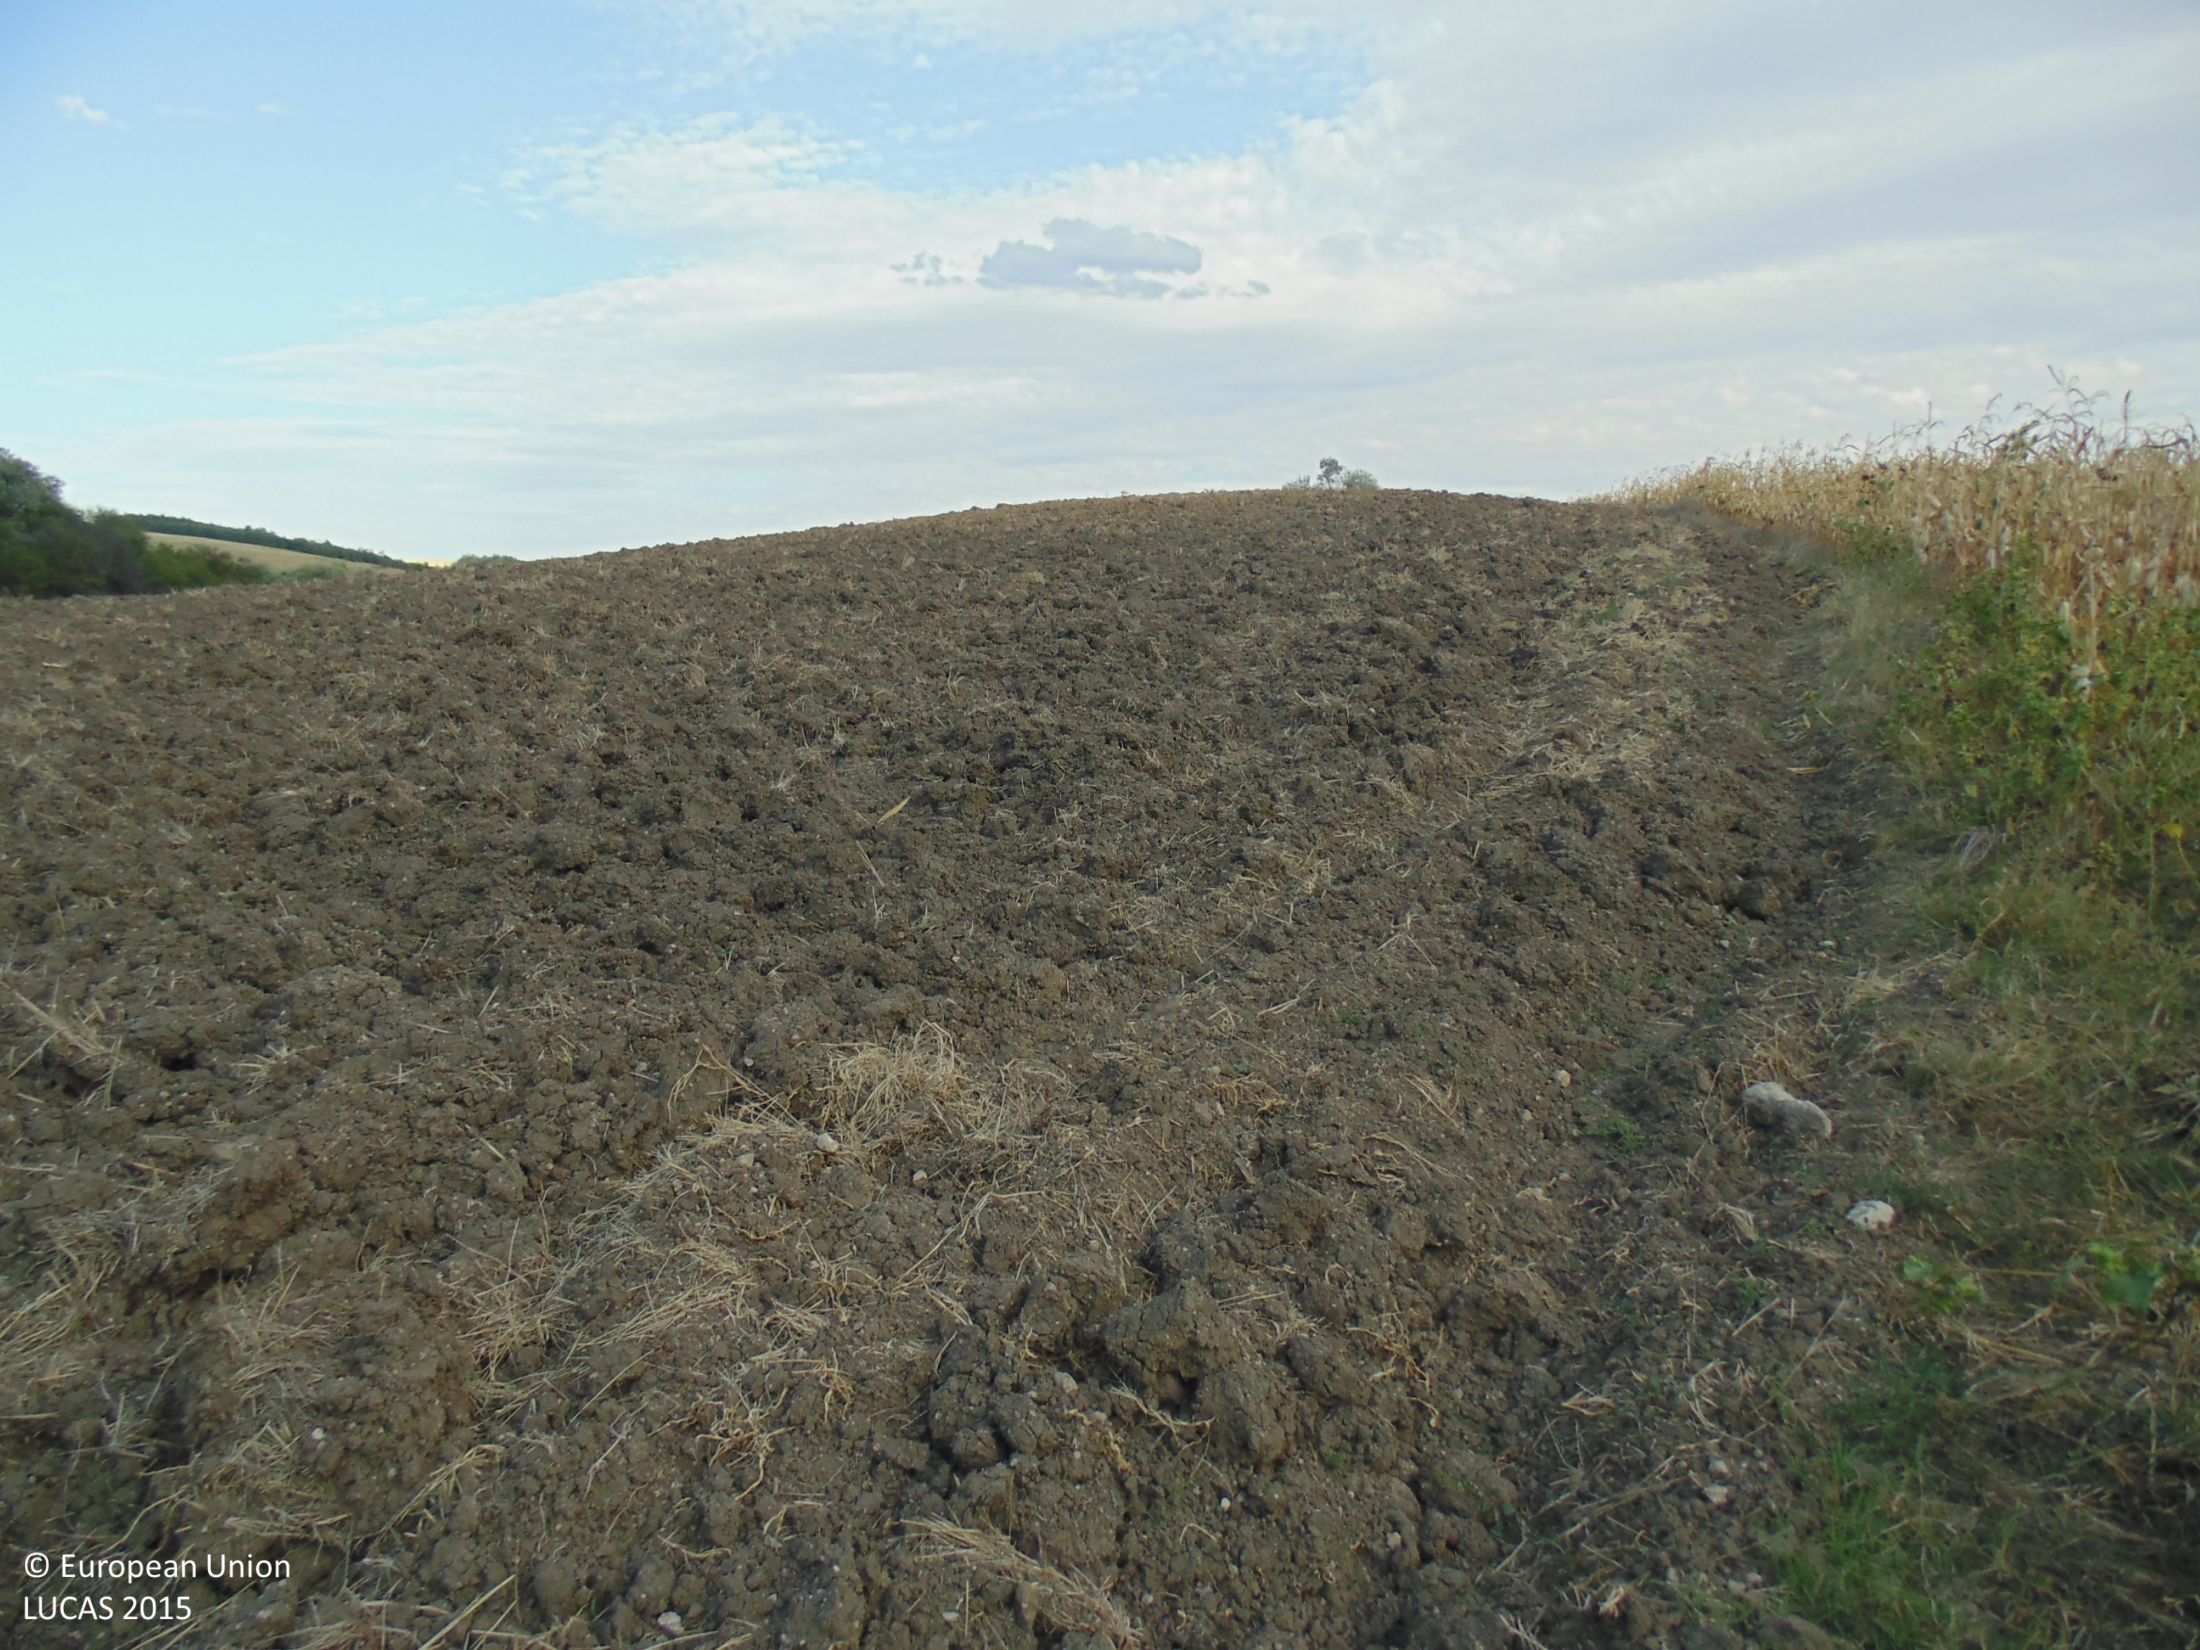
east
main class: Cropland
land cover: Common wheat
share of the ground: < 10 %
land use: Agriculture (excluding fallow land and kitchen gardens)
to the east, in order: Grass margins; Common wheat
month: September
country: BG
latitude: 44.0701
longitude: 27.1459
